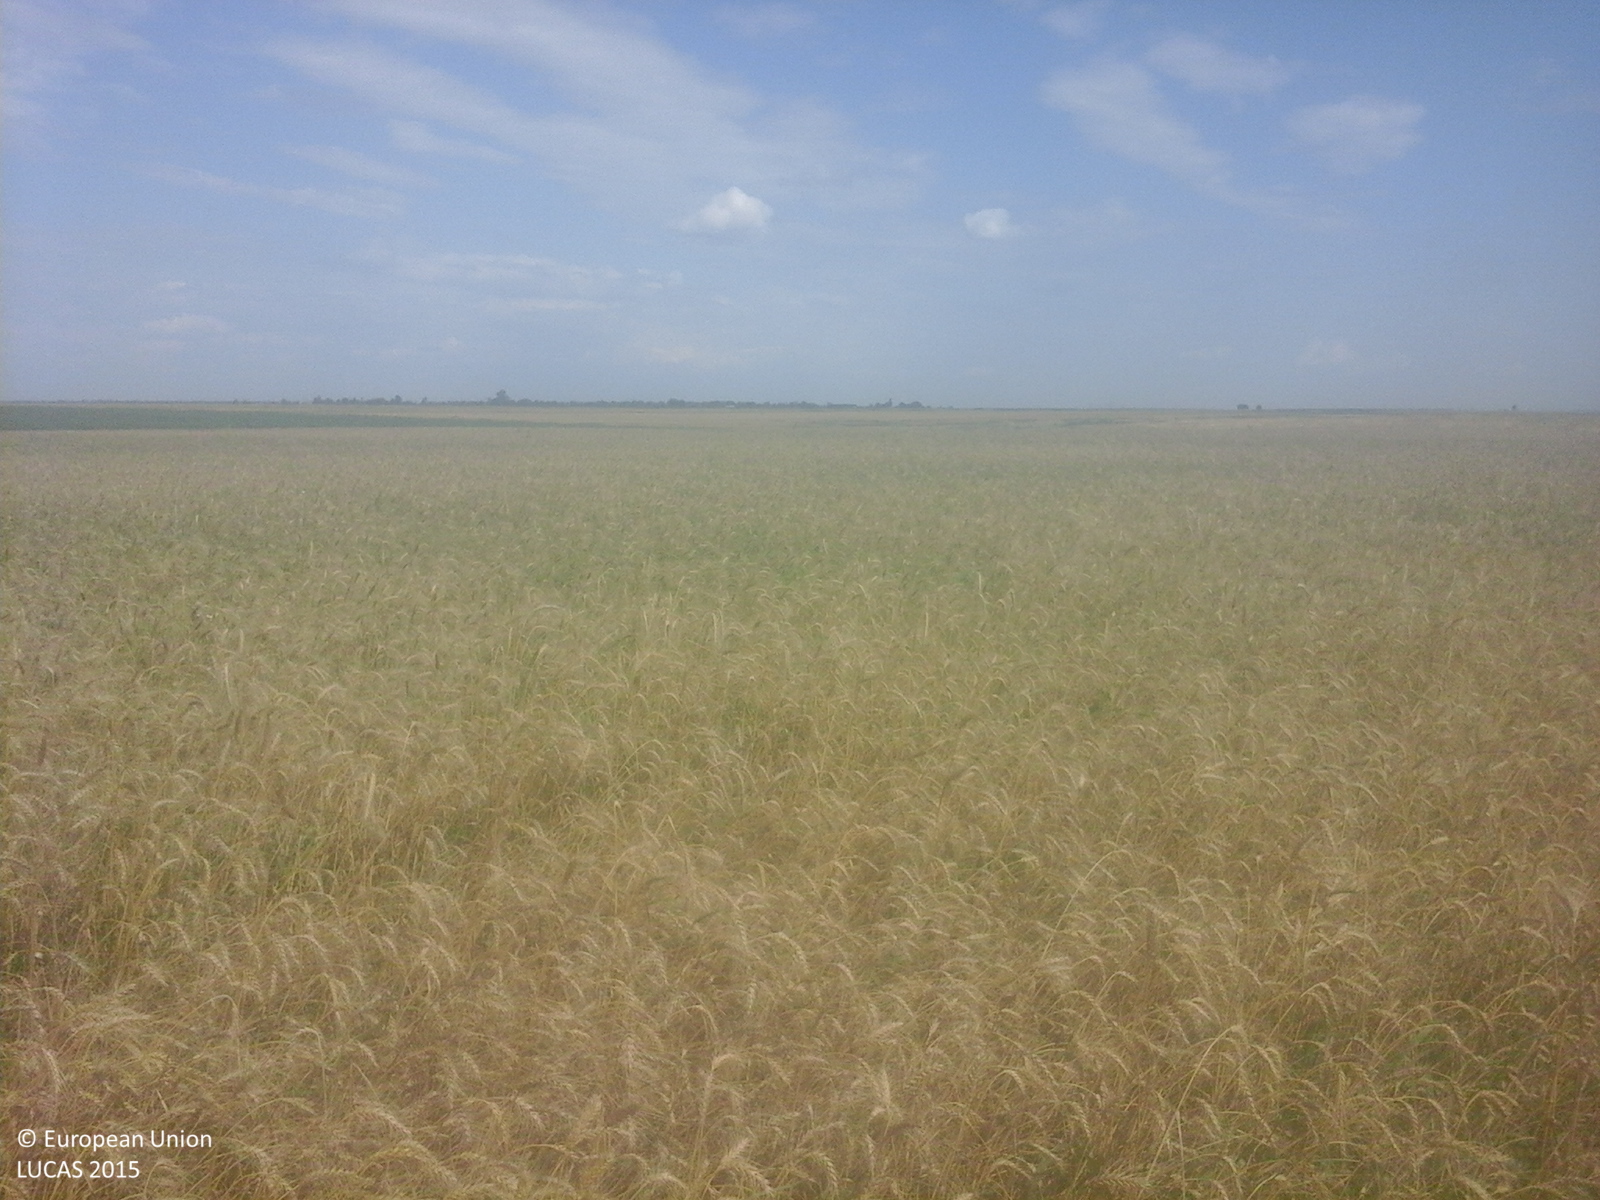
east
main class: Cropland
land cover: Common wheat
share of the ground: > 75 %
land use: Agriculture (excluding fallow land and kitchen gardens)
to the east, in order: Common wheat; Spontaneously vegetated surfaces; Ditches and canals; Arable land (only in case pi)
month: July
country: RO
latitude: 44.0747
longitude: 25.5087
